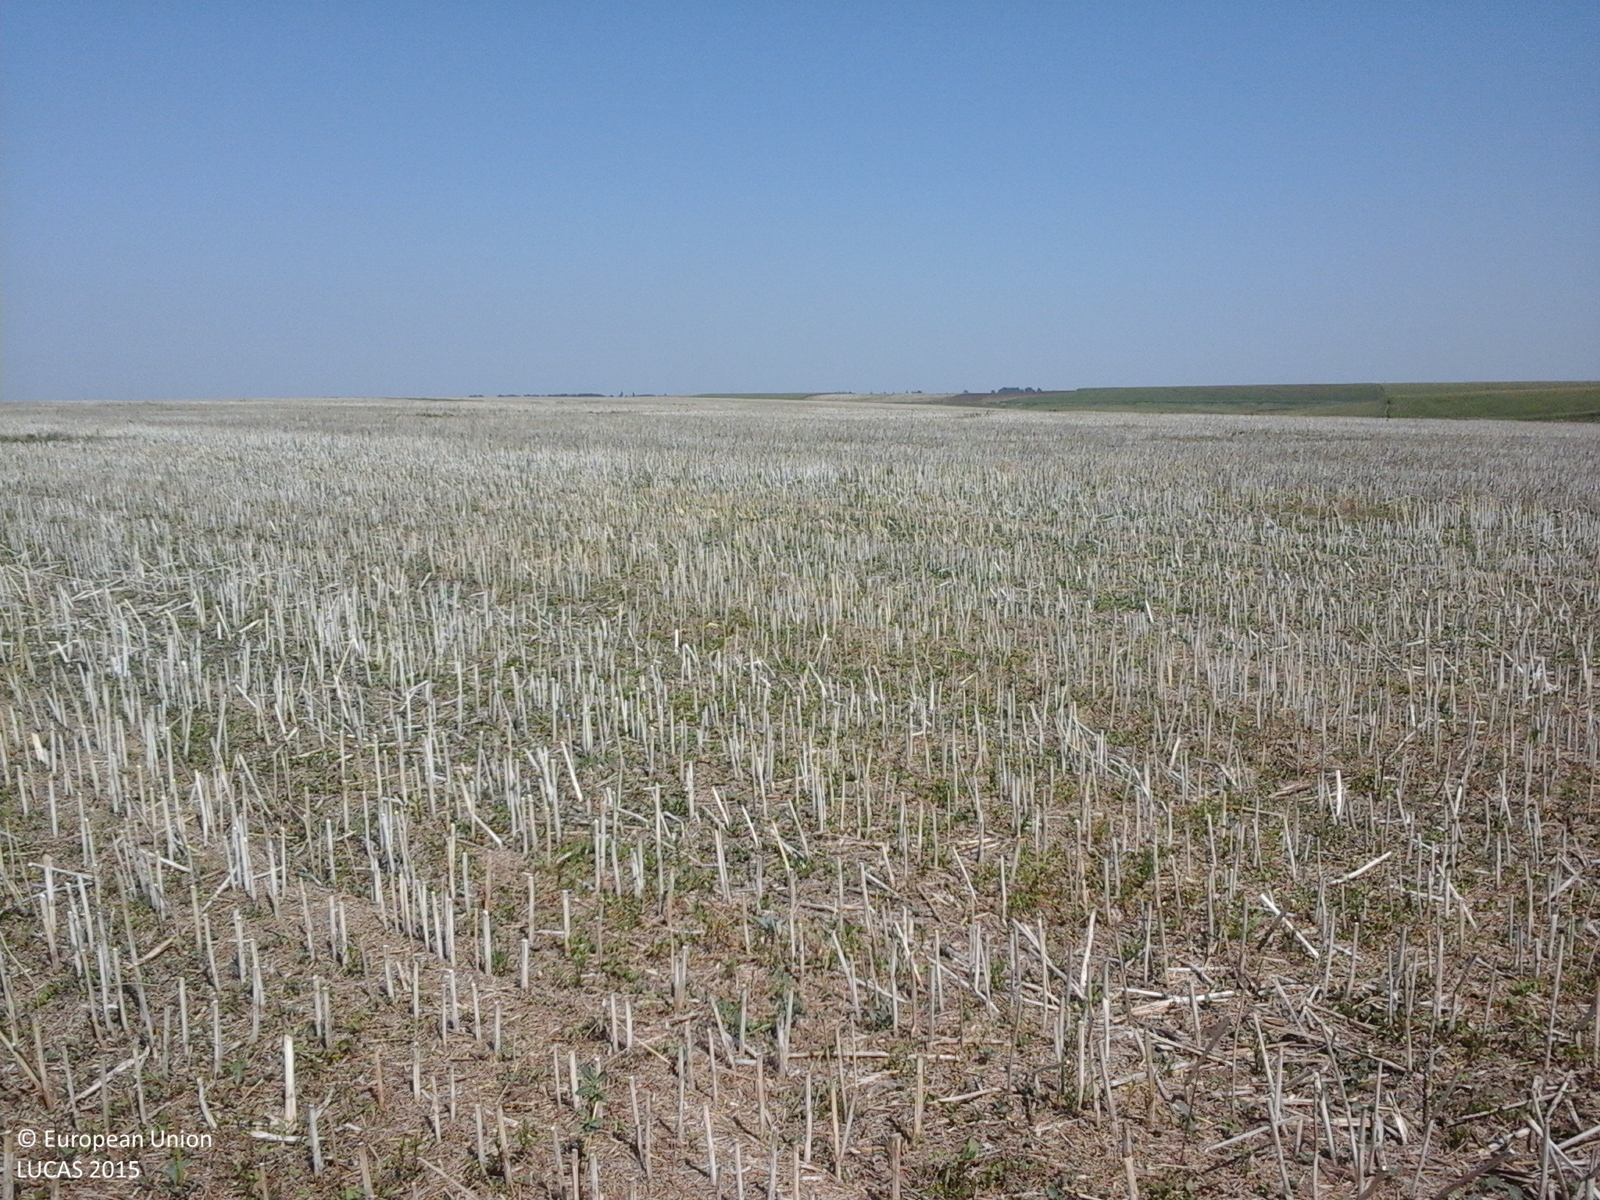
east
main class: Cropland
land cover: Rape and turnip rape
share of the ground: 25 - 50 %
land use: Agriculture (excluding fallow land and kitchen gardens)
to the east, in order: Rape and turnip rape
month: July
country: RO
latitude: 44.3774
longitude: 26.6217
